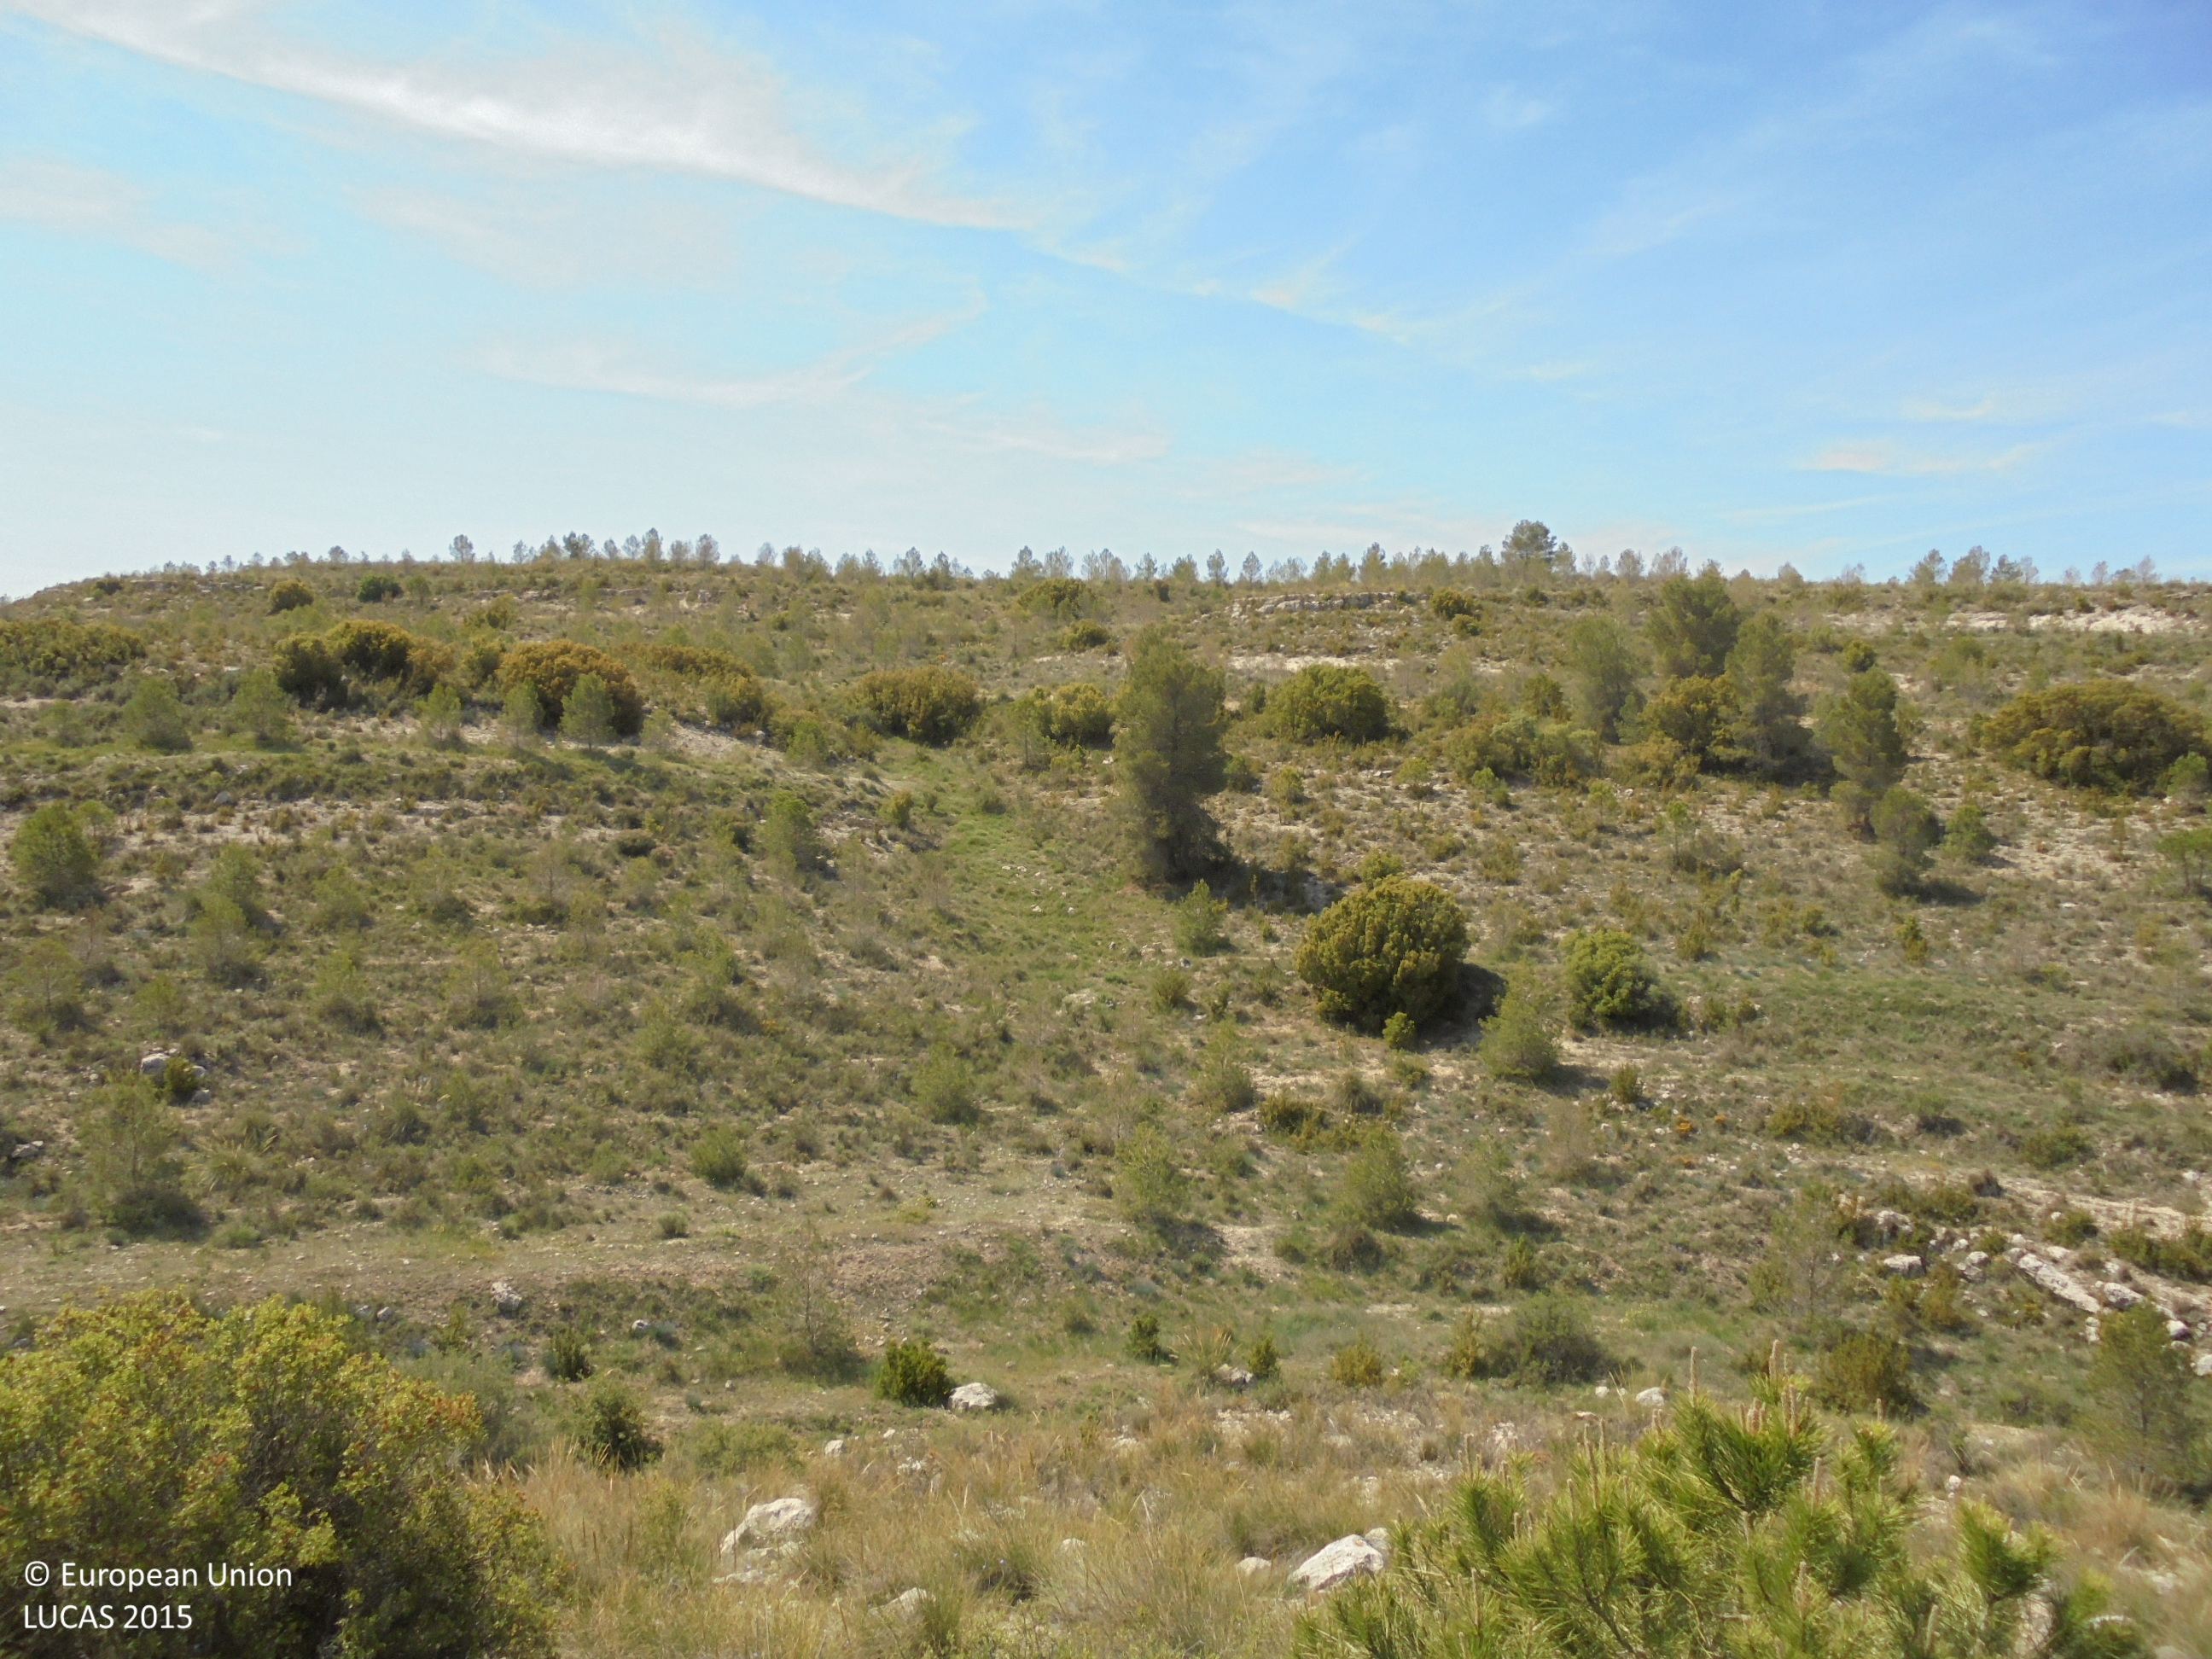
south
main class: Shrubland
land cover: Shrubland without tree cover
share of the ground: 50 - 75 %
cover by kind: shrubs 70 %, consolidated bare surface 15 %, unconsolidated bare surface 15 %
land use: Semi-natural and natural areas not in use
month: May
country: ES
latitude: 39.1515
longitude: -1.4902
